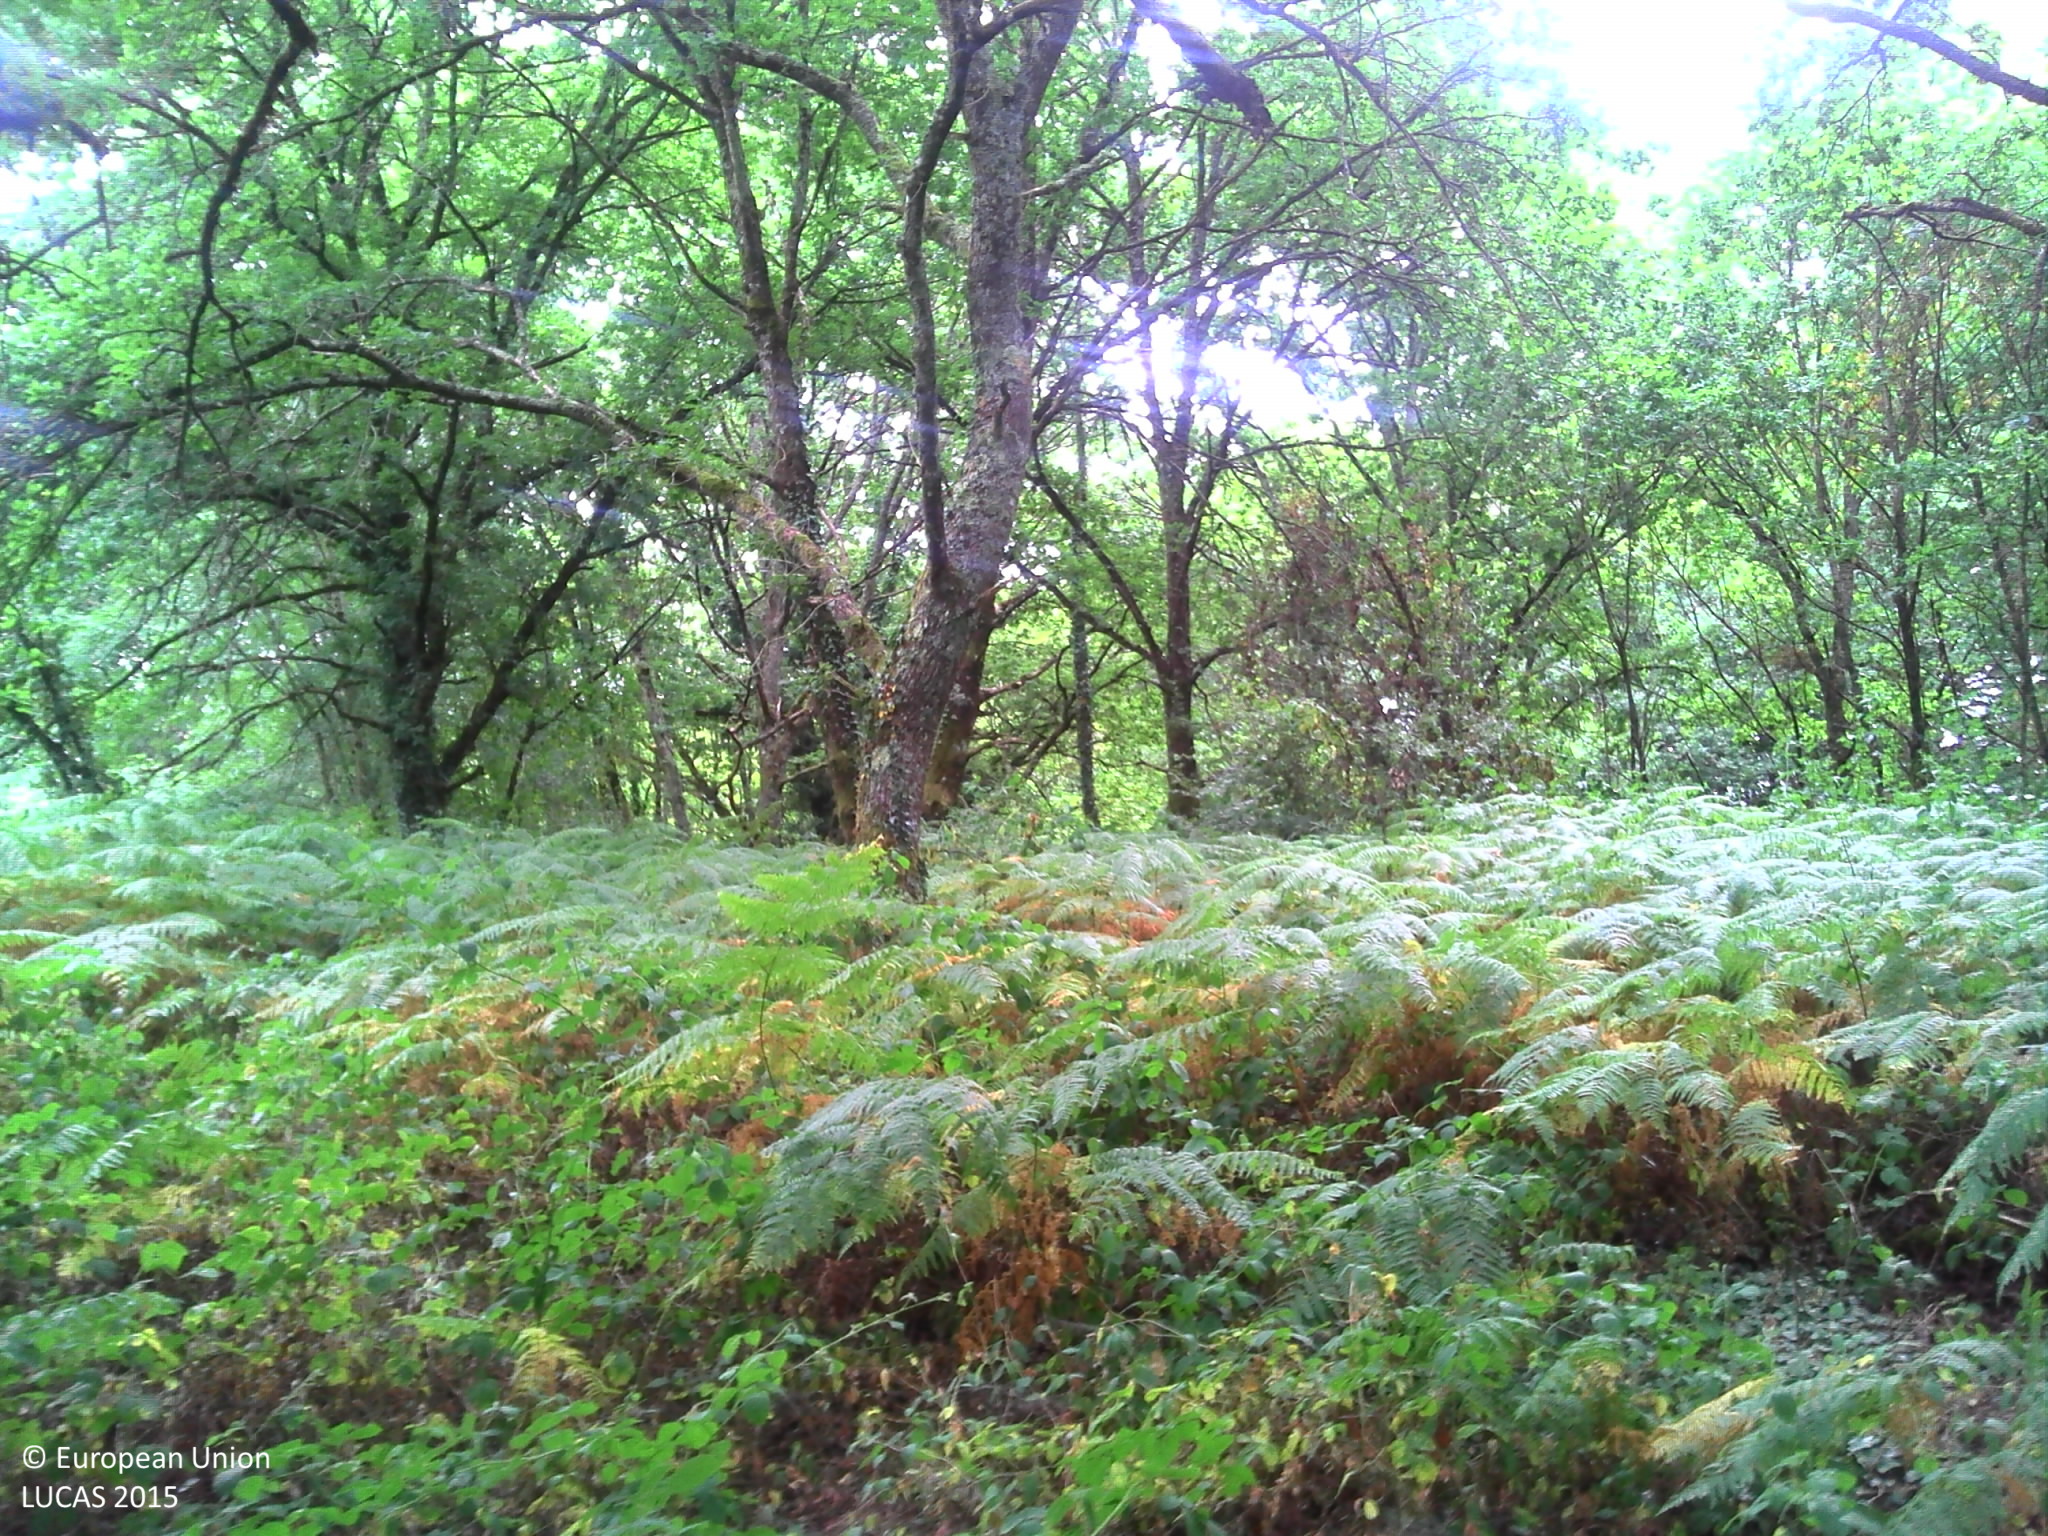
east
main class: Woodland
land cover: Broadleaved woodland
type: mesophytic deciduous forest
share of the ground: > 75 %
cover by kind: broadleaved forest trees 85 %, herbaceous plants 10 %, shrubs 5 %
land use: Forestry
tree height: > 5 m
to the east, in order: Broadleaved woodland; Shrubland with sparse tree cover; Electric lines; Shrubland with sparse tree cover; Broadleaved woodland; Fences; Grassland without tree/shrub cover; Tracks; Grassland without tree/shrub cover
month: July
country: FR
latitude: 46.4006
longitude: 1.6014
